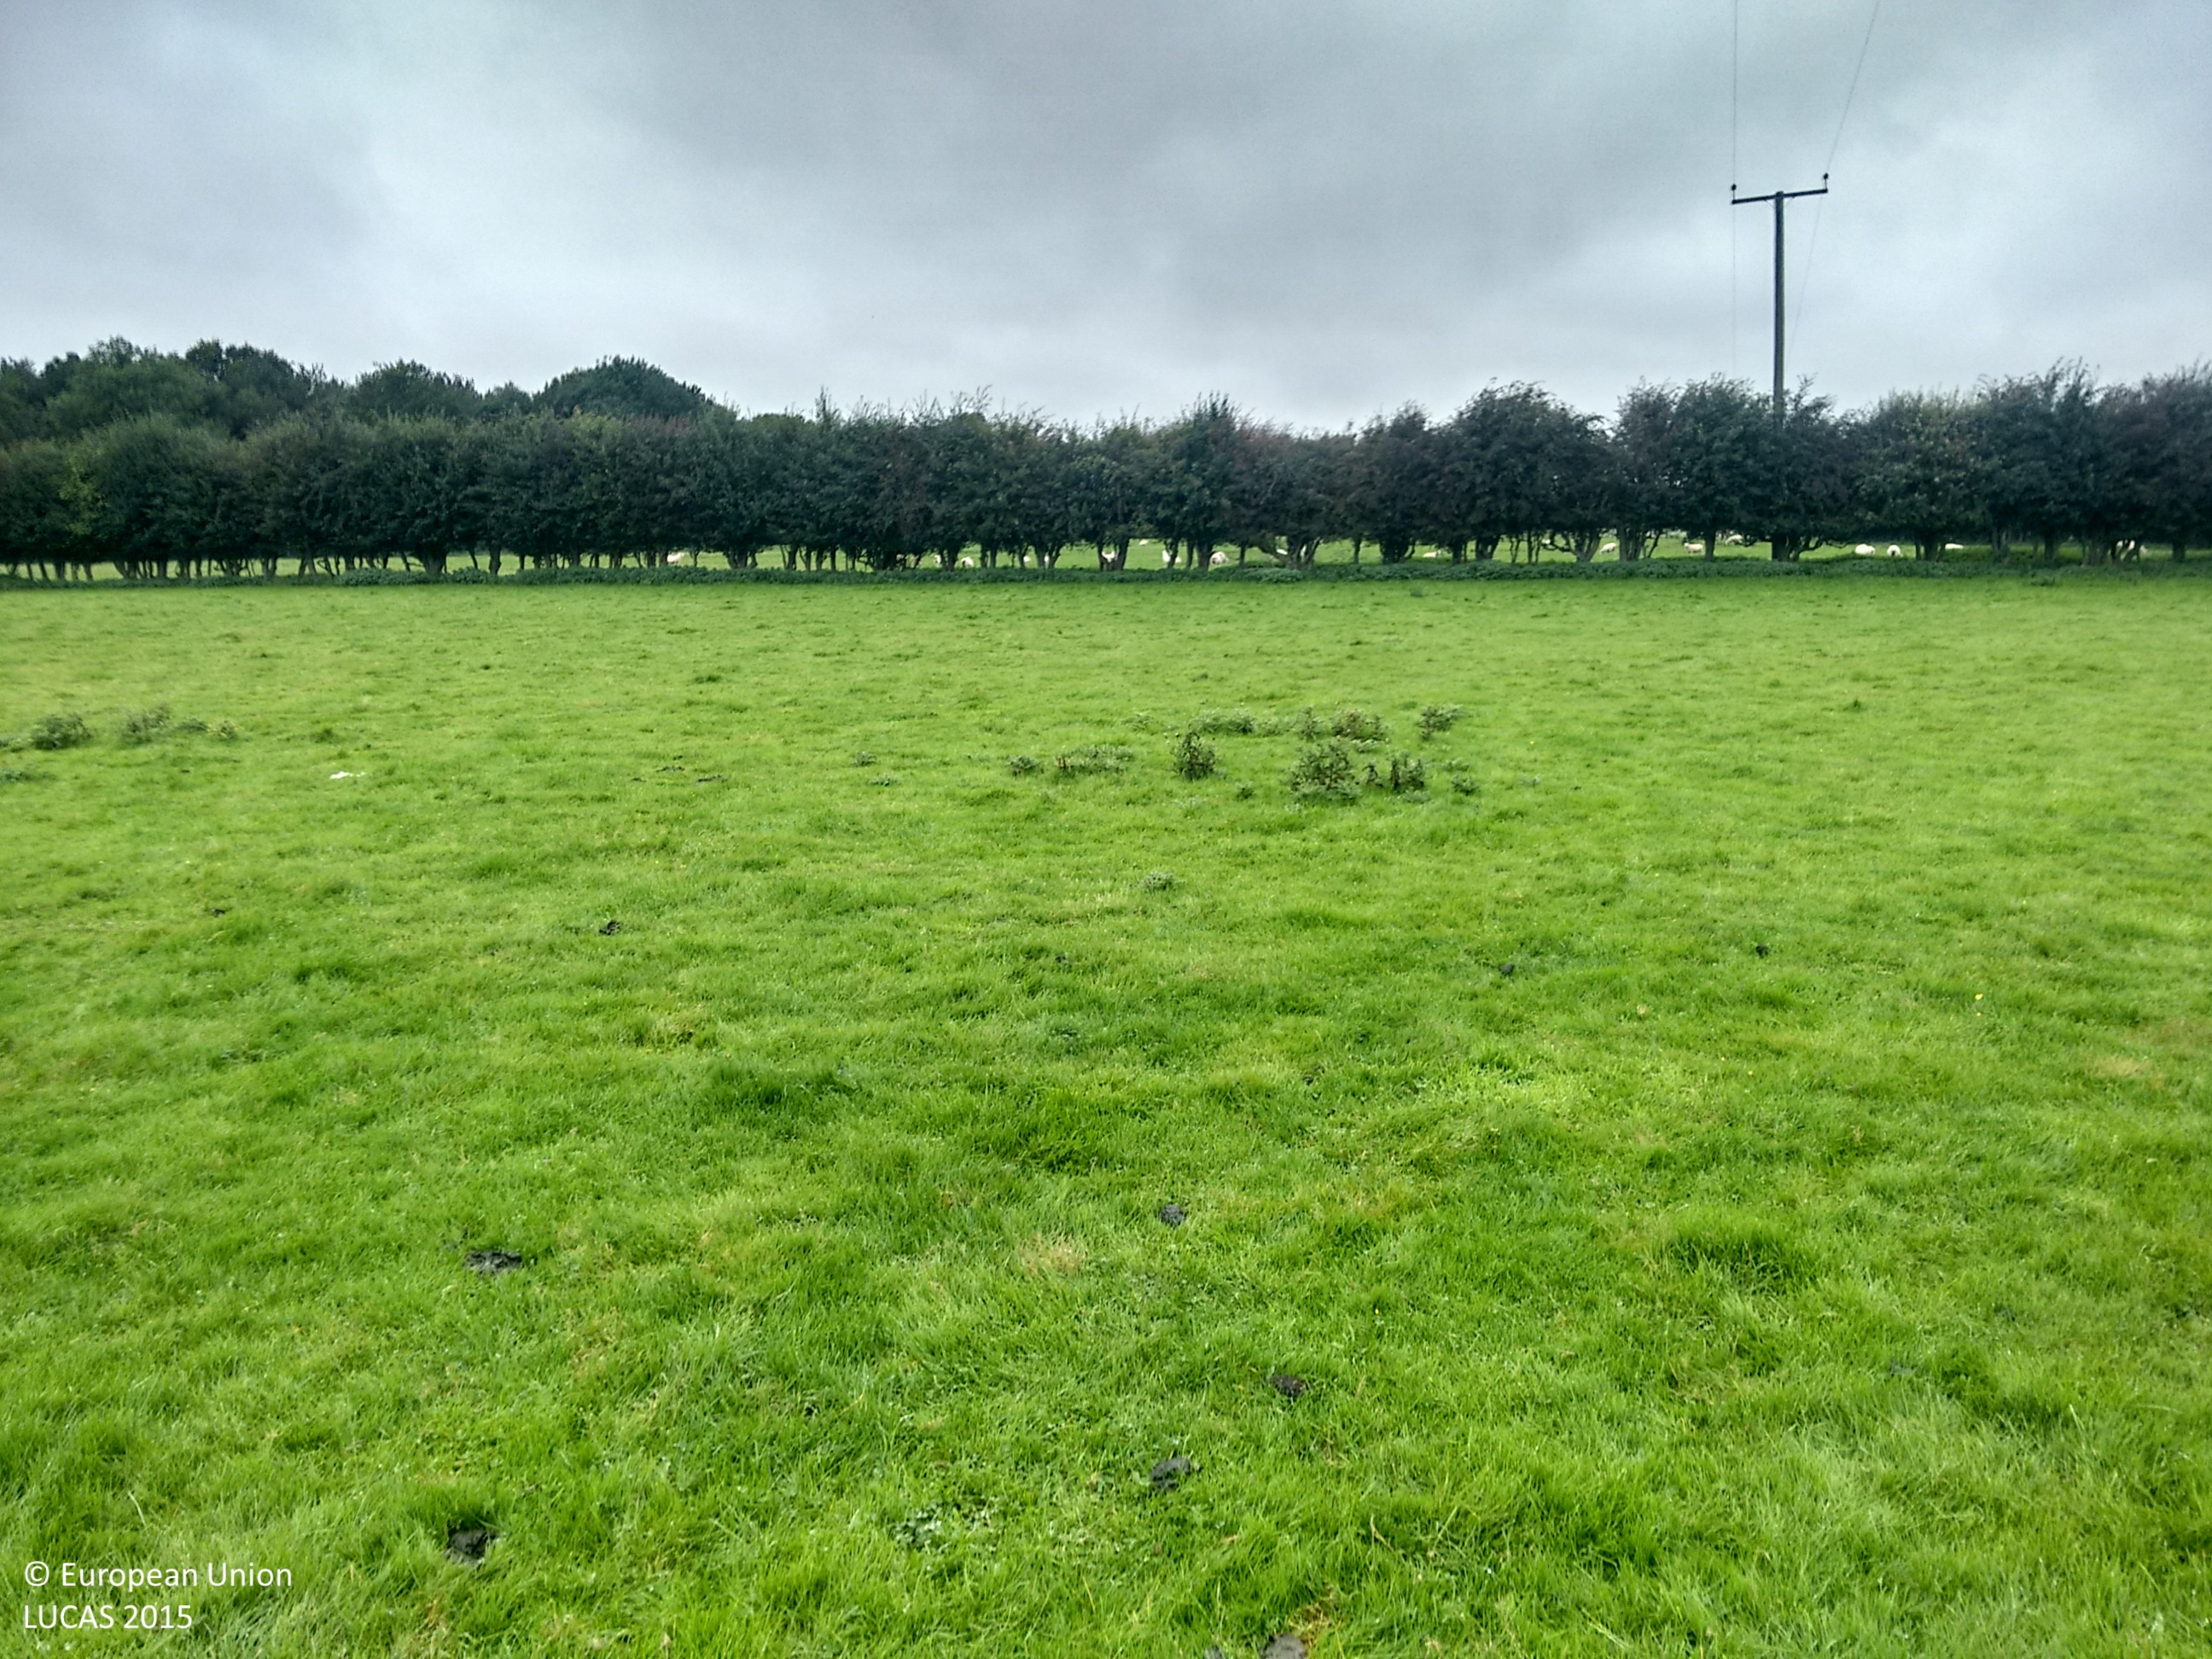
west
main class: Grassland
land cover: Grassland without tree/shrub cover
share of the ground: > 75 %
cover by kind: herbaceous plants 100 %
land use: Agriculture (excluding fallow land and kitchen gardens)
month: October
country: GB
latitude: 51.3185
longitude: 0.6325
